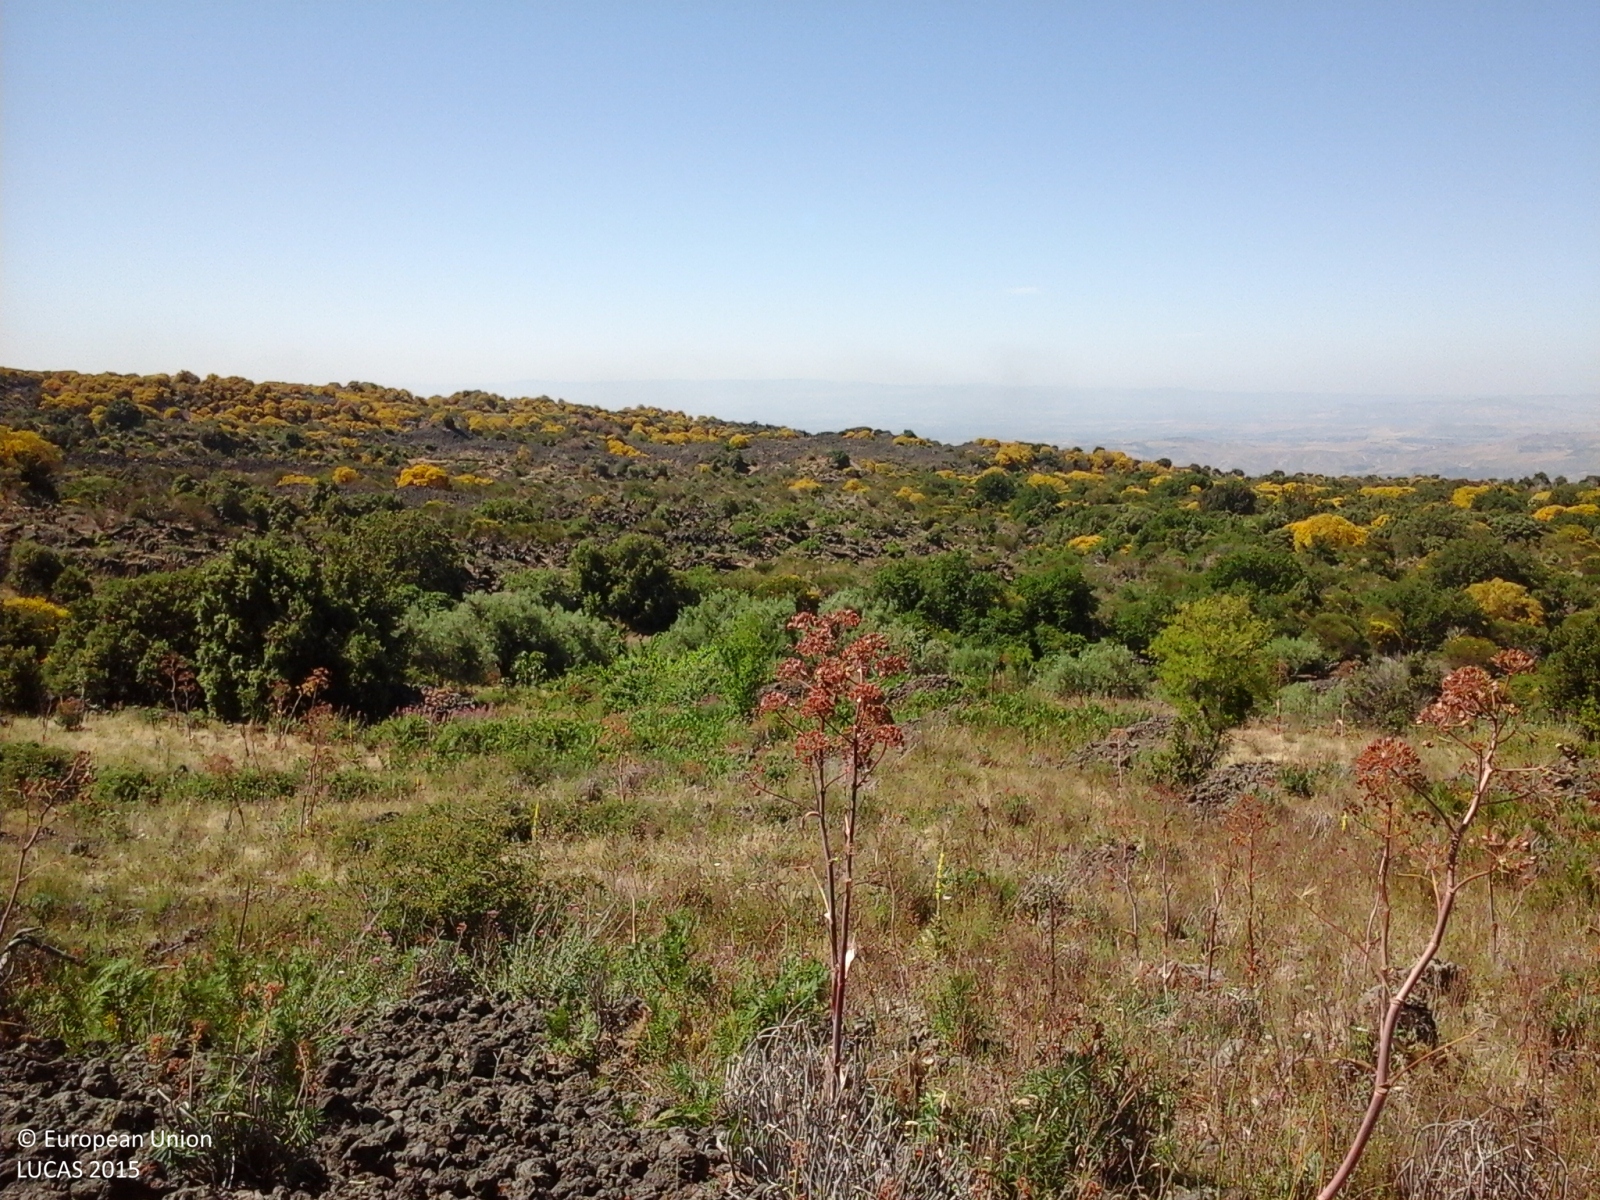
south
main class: Shrubland
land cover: Shrubland with sparse tree cover
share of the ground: > 75 %
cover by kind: shrubs 95 %, broadleaved forest trees 5 %
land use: Amenities, museums, leisure
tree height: < 5 m
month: June
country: IT
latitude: 37.6951
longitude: 14.8764
